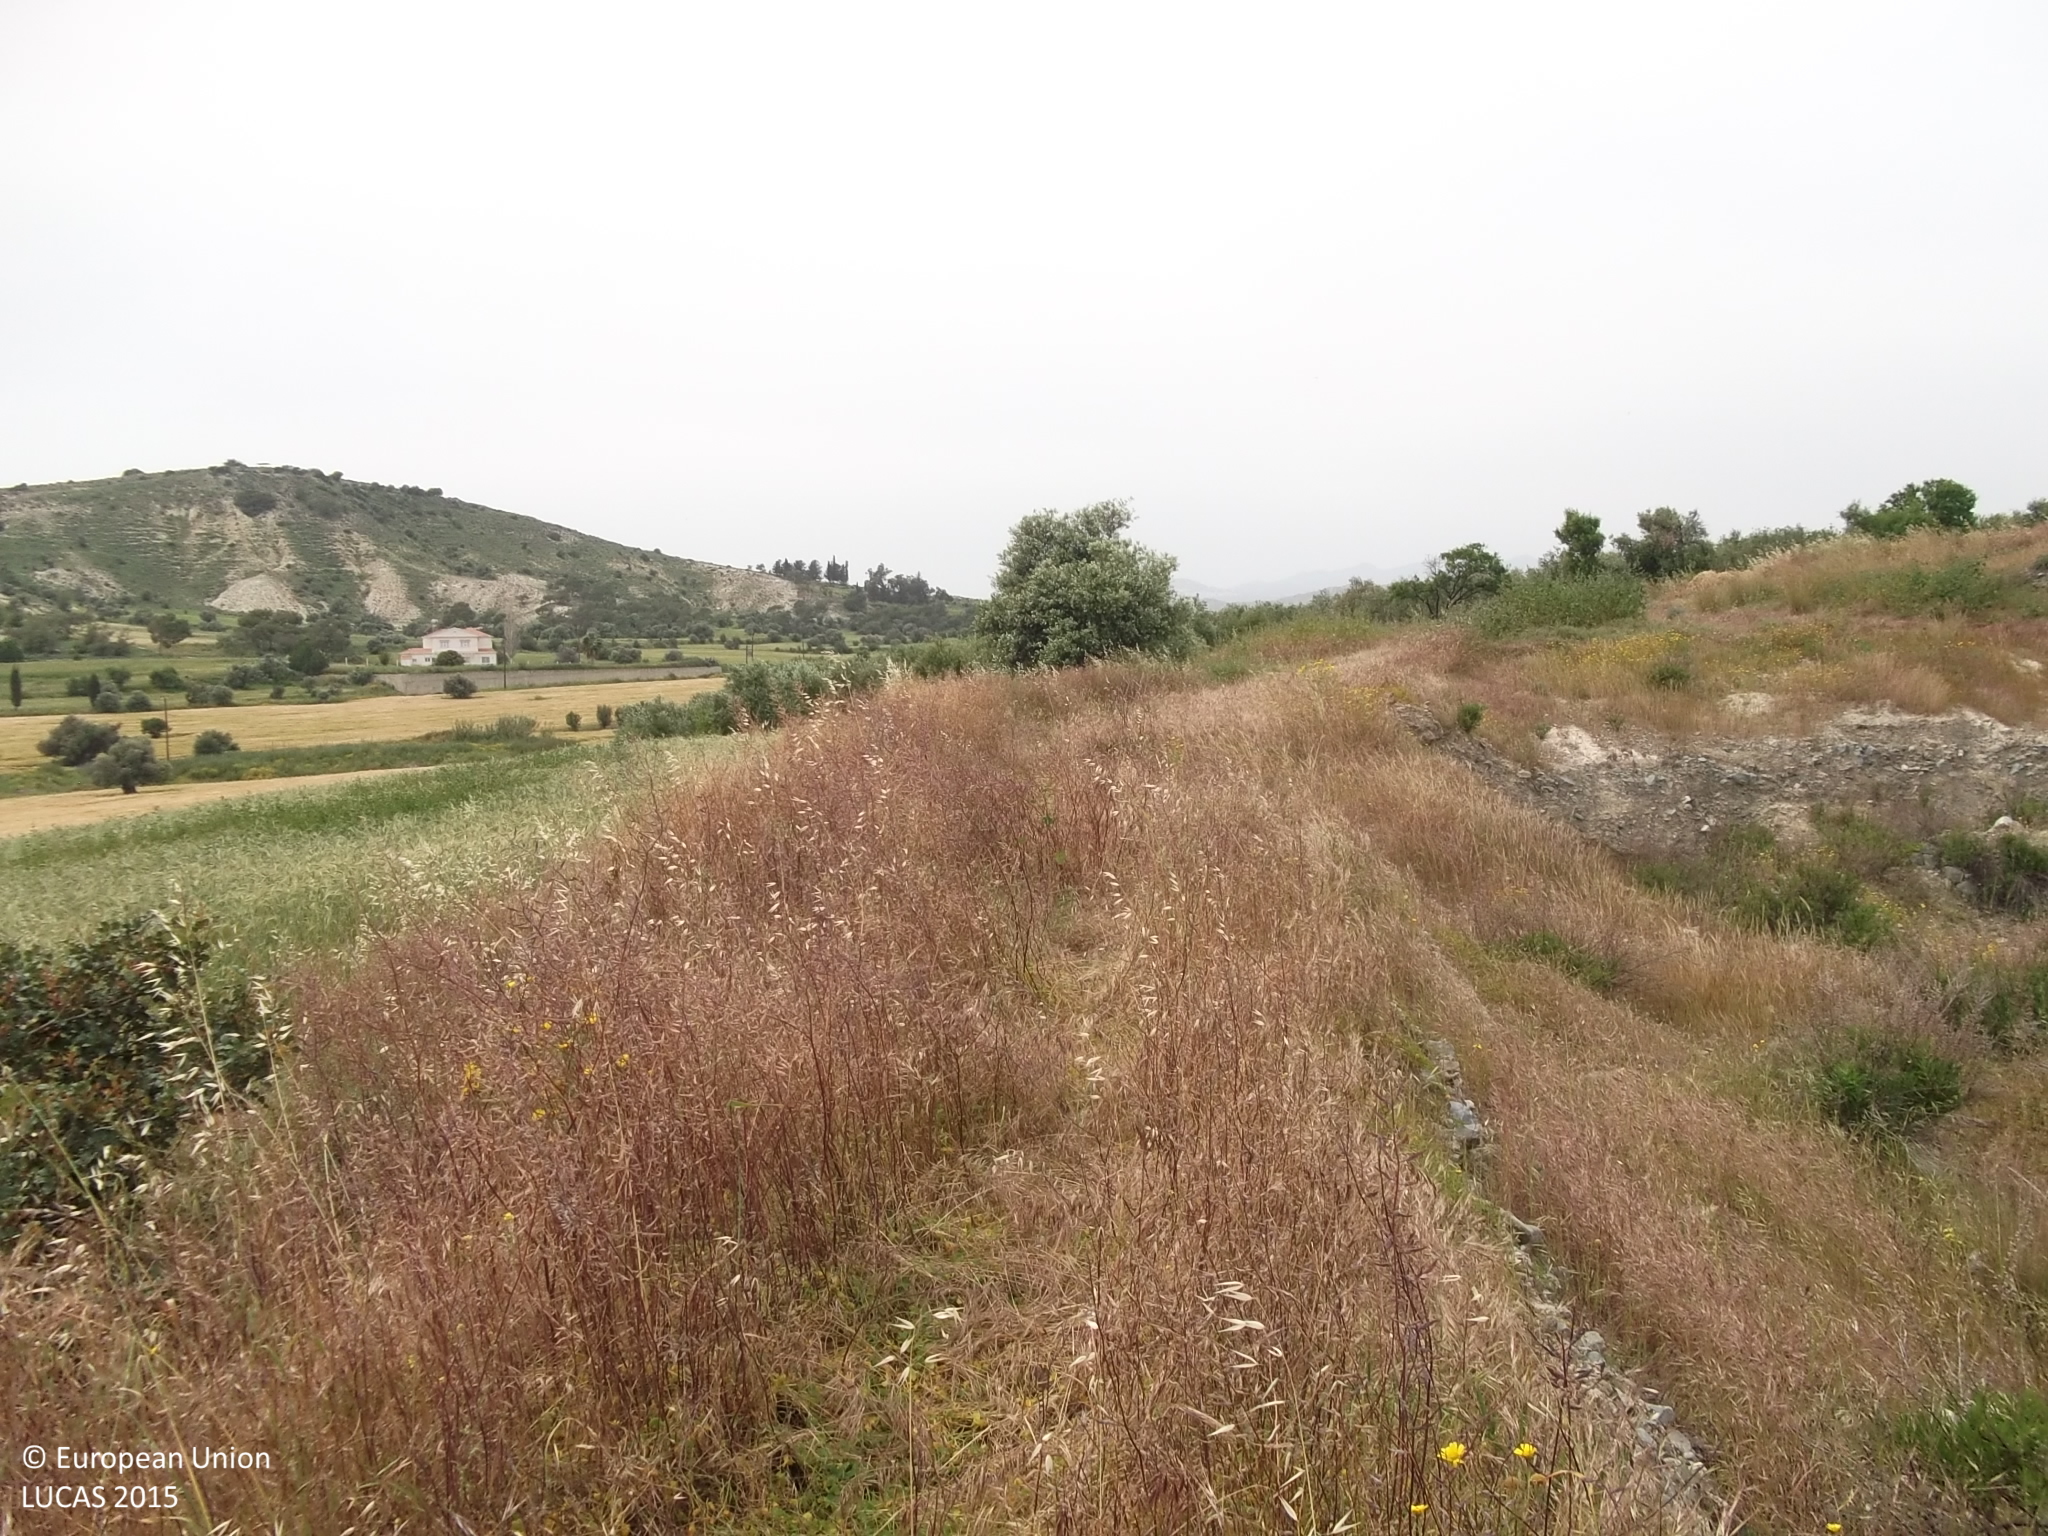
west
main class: Grassland
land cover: Spontaneously vegetated surfaces
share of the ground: > 75 %
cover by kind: herbaceous plants 85 %, unconsolidated bare surface 15 %
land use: Semi-natural and natural areas not in use
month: April
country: CY
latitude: 34.8415
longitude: 33.4694
